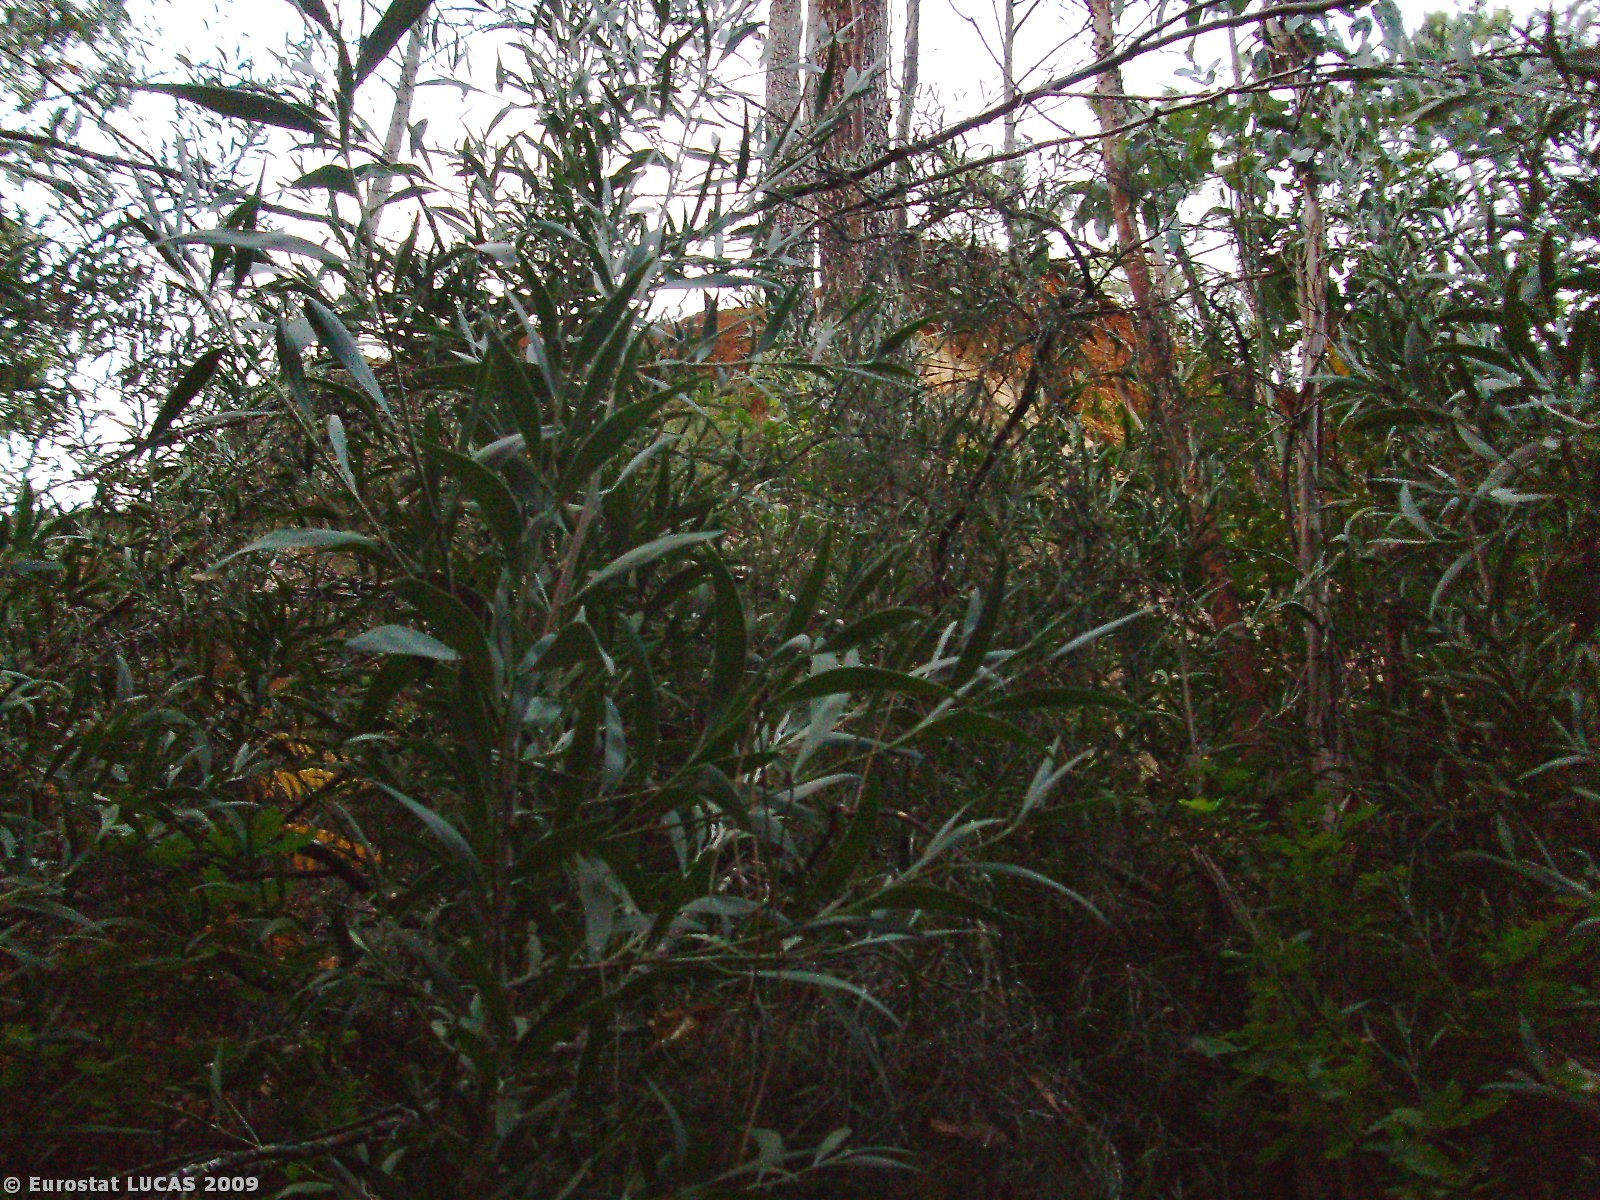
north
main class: Woodland
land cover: Broadleaved woodland
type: thermophilous deciduous forest
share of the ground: 25 - 50 %
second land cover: Shrubland with sparse tree cover
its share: 50 - 75 %
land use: Forestry
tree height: > 5 m
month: August
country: PT
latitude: 40.0583
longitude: -8.3313
